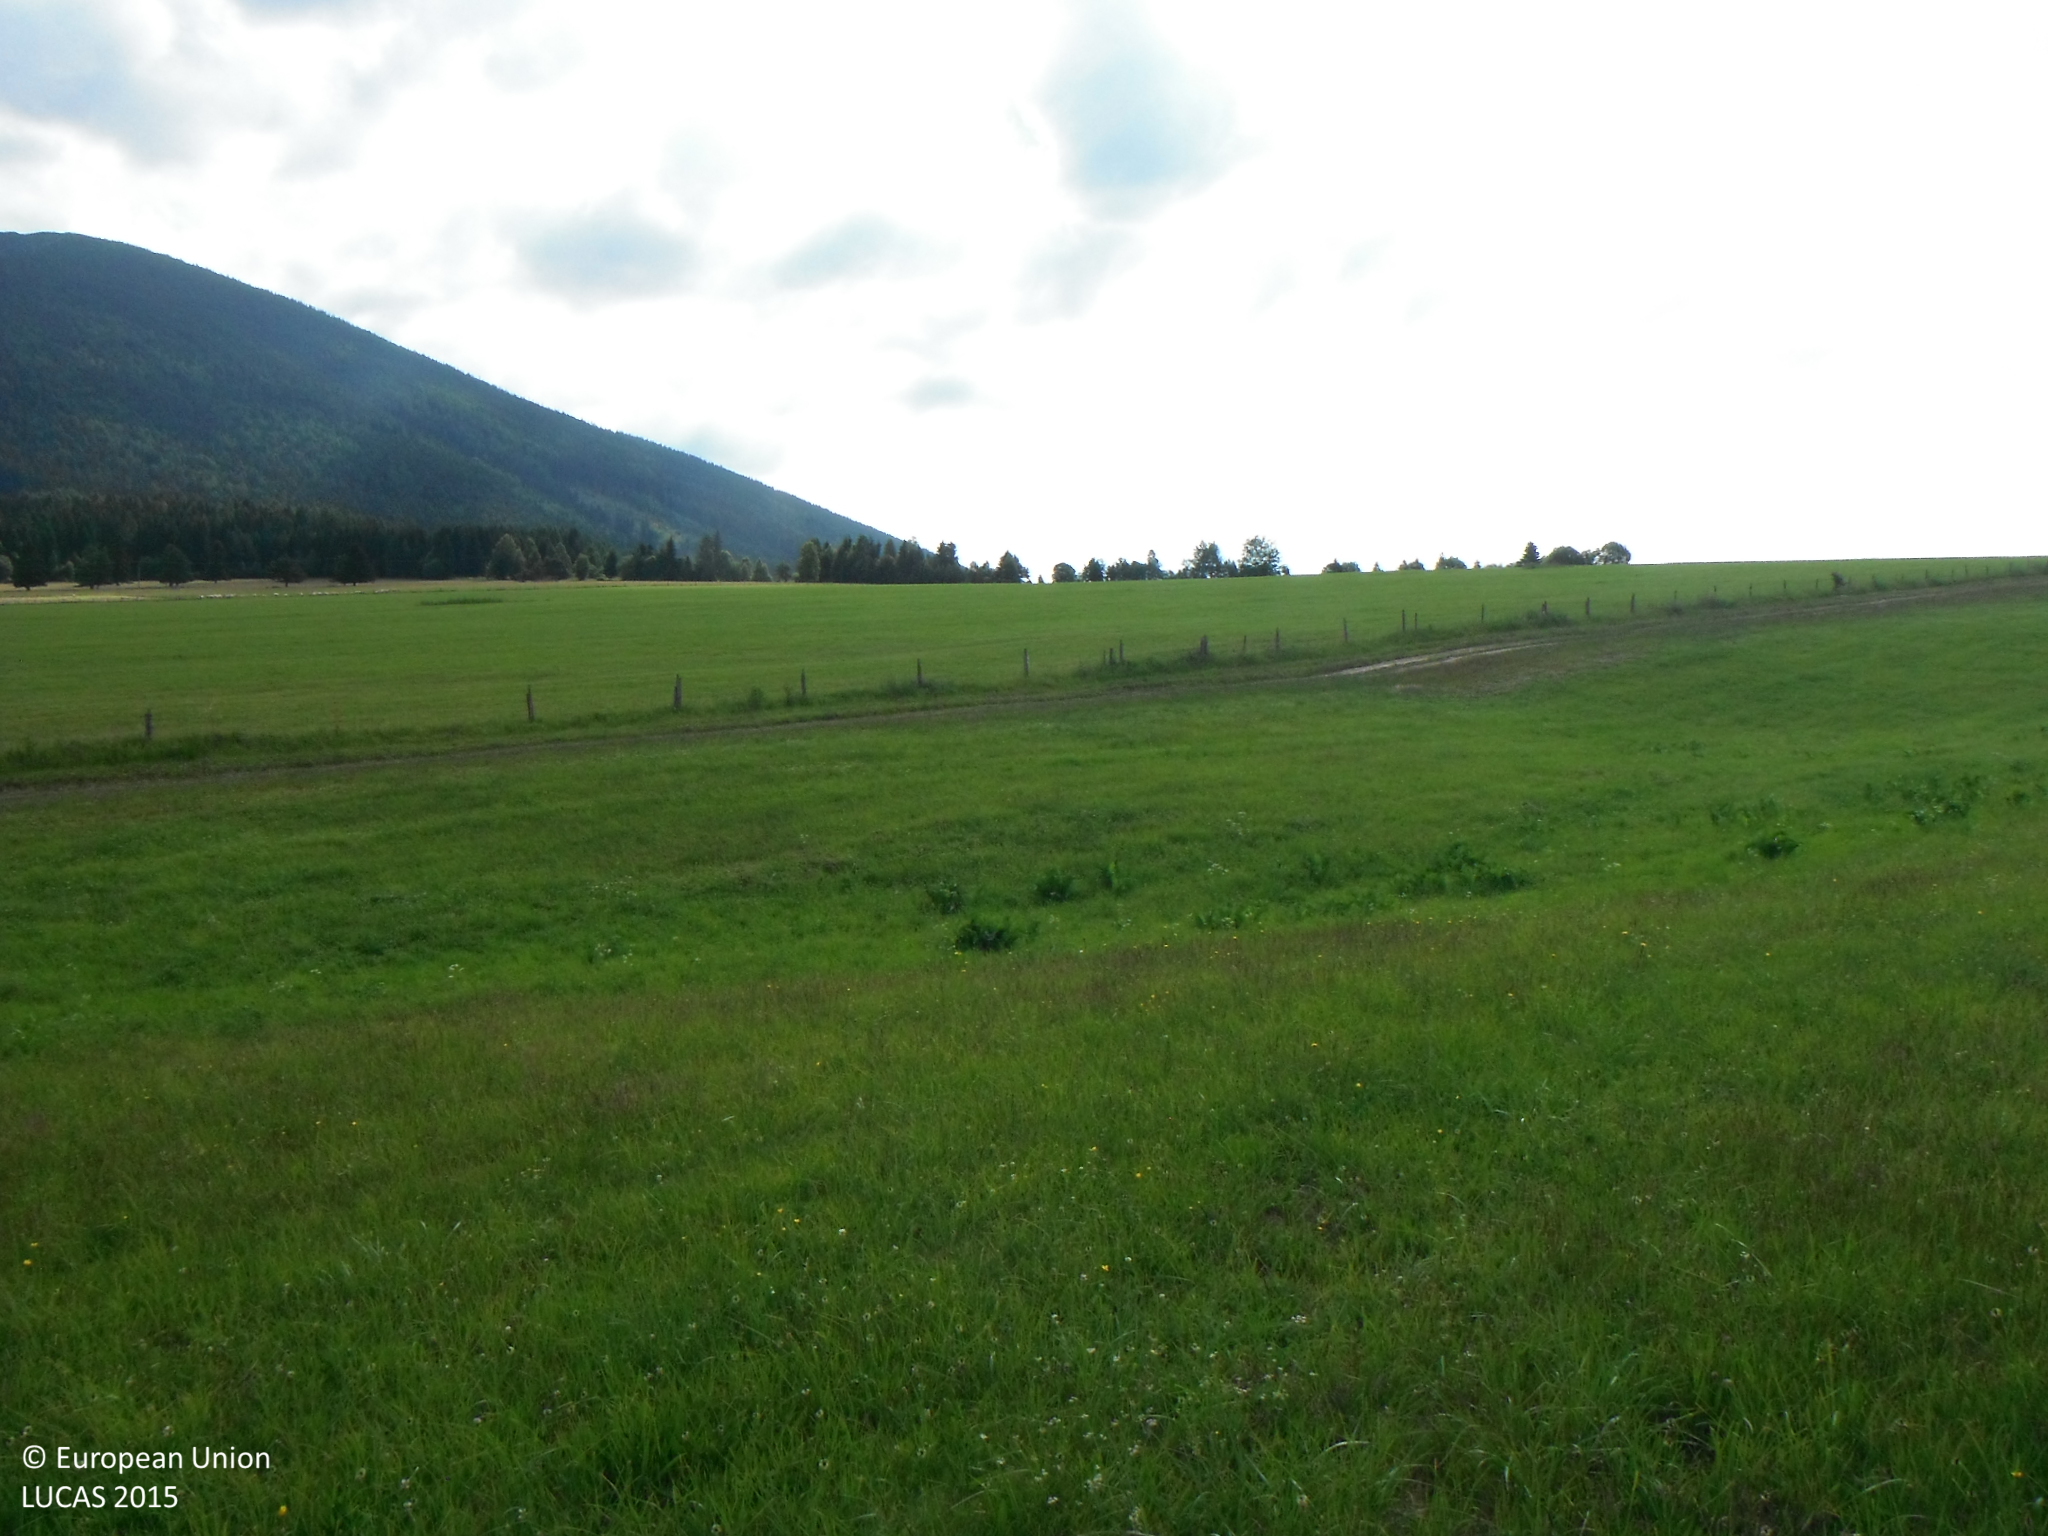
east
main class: Grassland
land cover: Grassland without tree/shrub cover
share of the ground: > 75 %
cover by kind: herbaceous plants 100 %
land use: Agriculture (excluding fallow land and kitchen gardens)
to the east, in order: Grassland without tree/shrub cover; Tracks; Grassland without tree/shrub cover; Fences; Grassland without tree/shrub cover
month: July
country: SK
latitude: 49.1365
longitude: 19.6910
